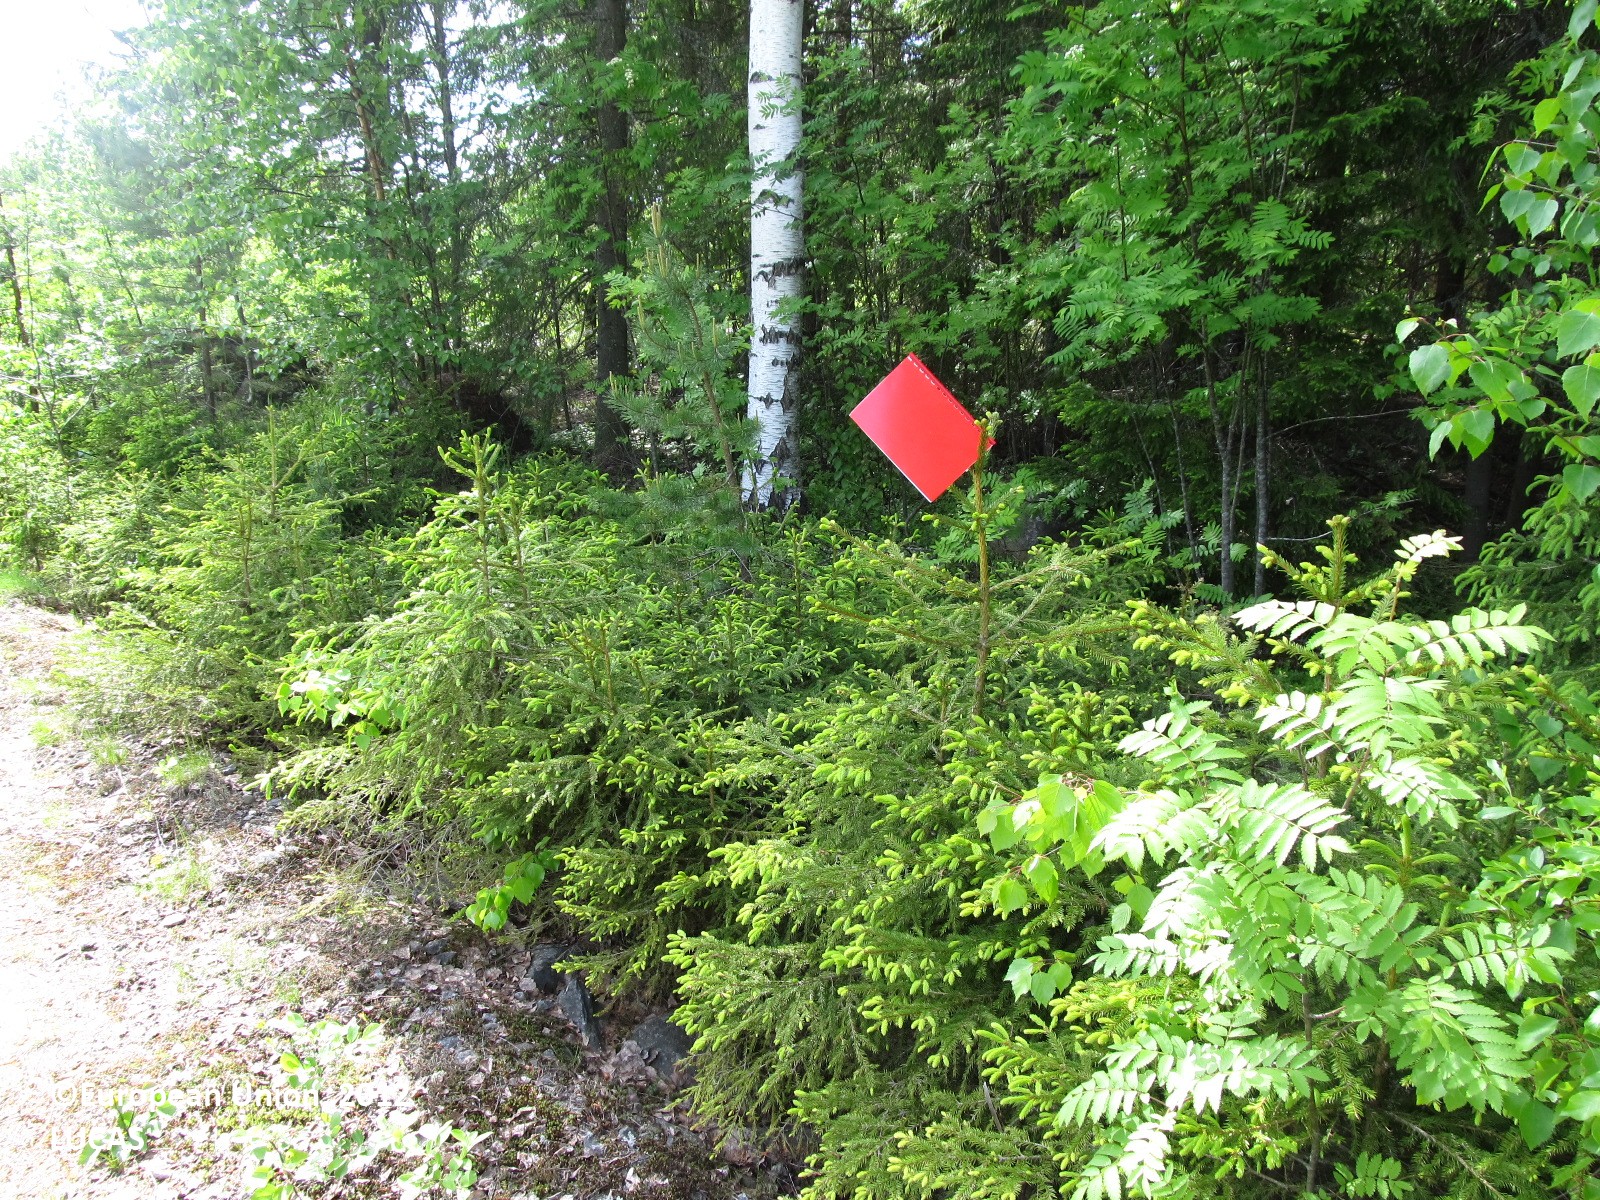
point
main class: Artificial land
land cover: Non built-up linear features
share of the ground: 25 - 50 %
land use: Road transport
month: June
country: FI
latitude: 62.5545
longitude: 28.7435
